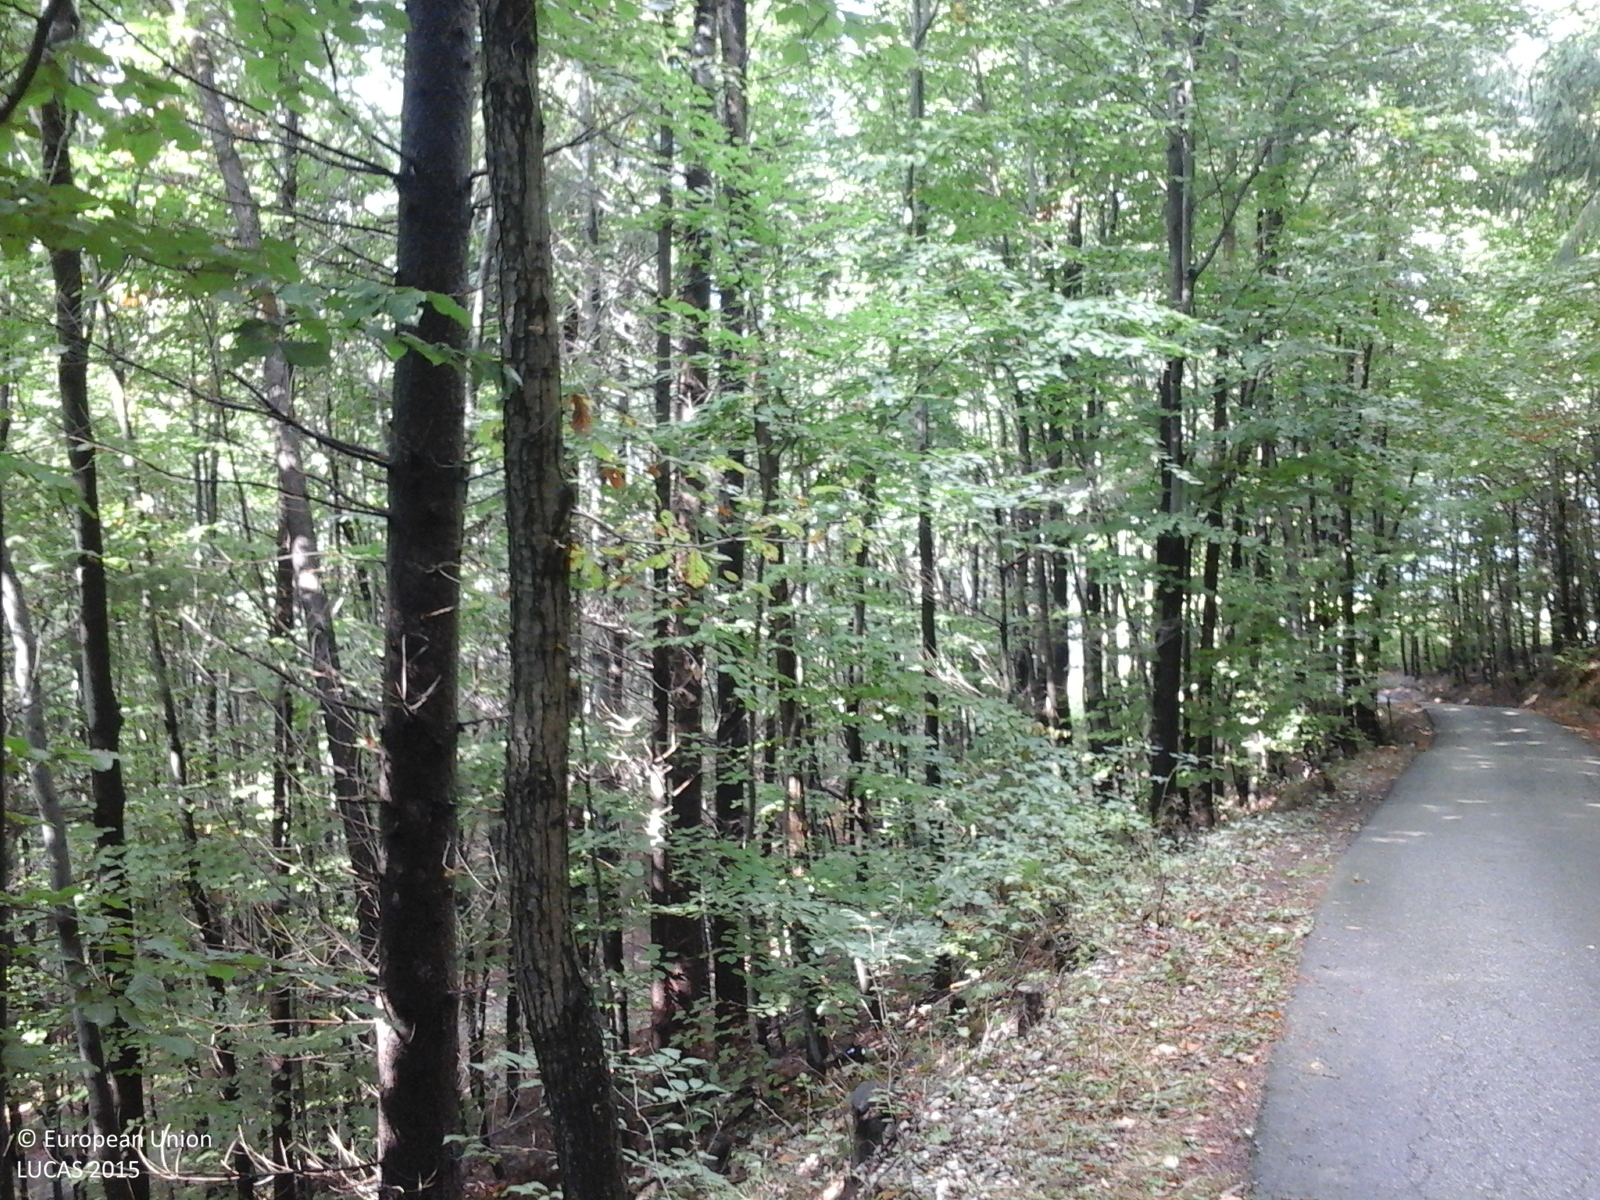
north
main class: Woodland
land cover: Other mixed woodland
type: beech forest
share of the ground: > 75 %
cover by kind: broadleaved forest trees 75 %, coniferous forest trees 25 %
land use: Forestry
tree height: > 5 m
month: September
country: RO
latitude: 45.1958
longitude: 24.4733
